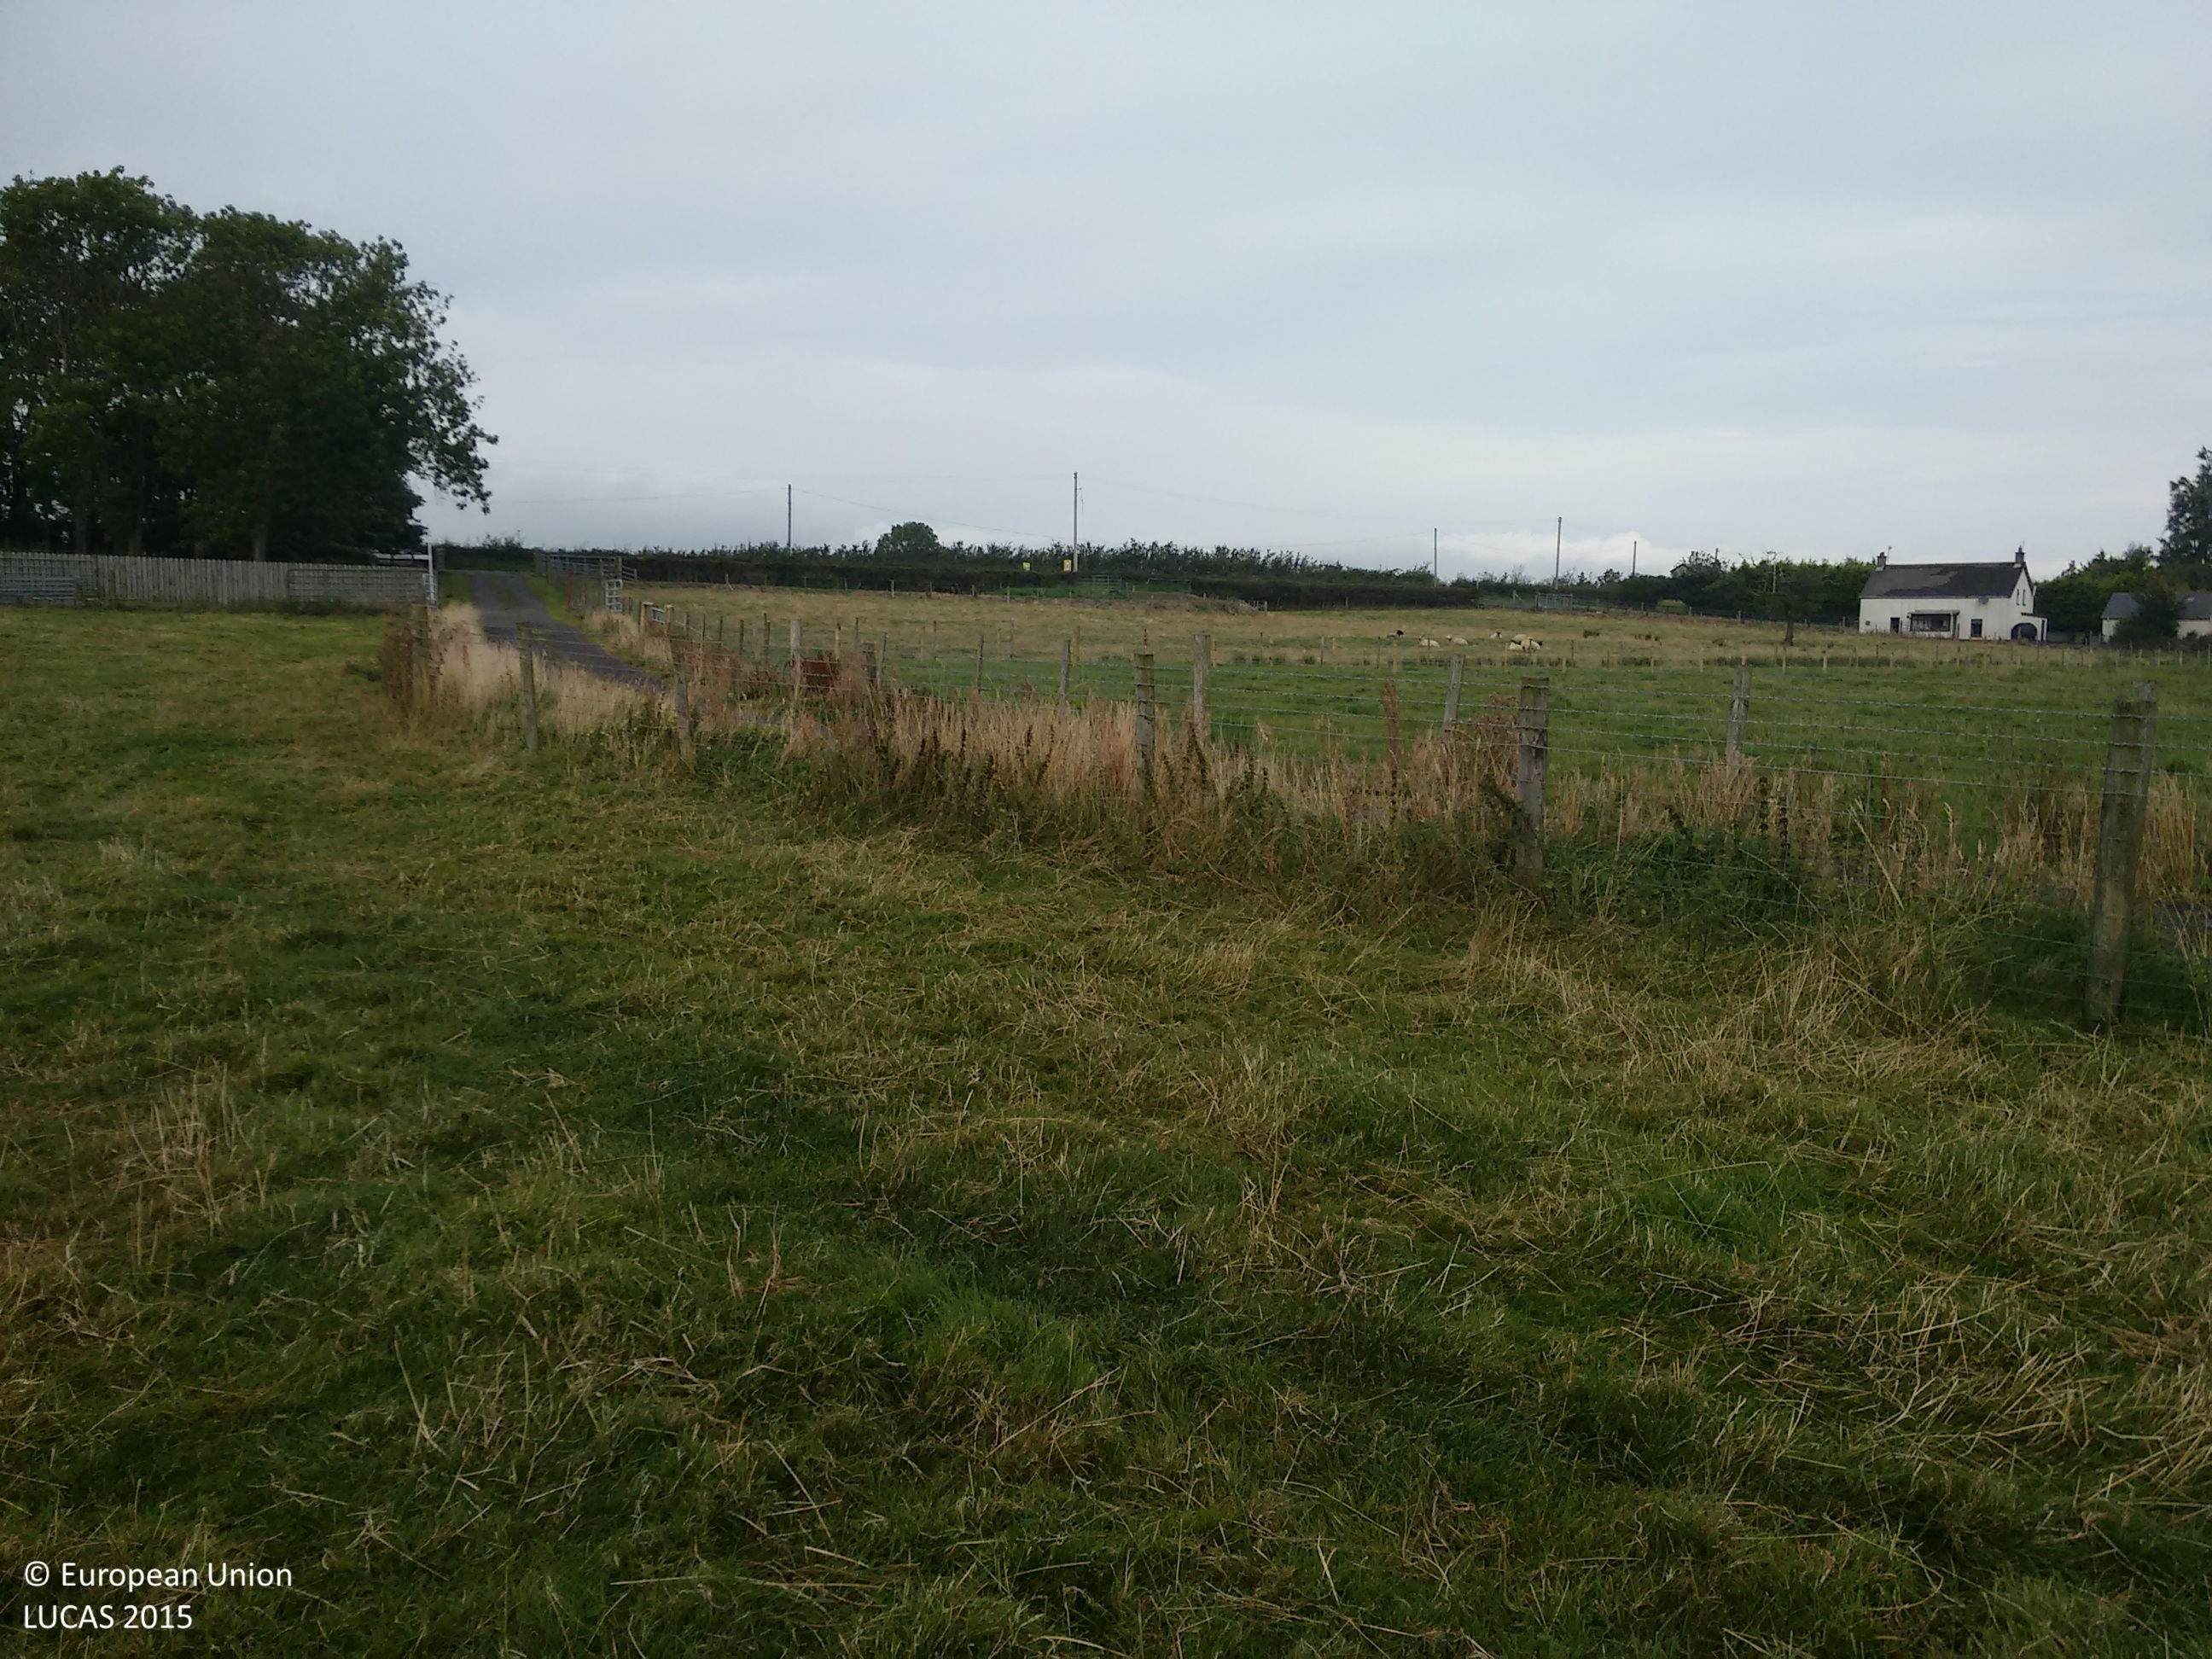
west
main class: Grassland
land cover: Grassland without tree/shrub cover
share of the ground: > 75 %
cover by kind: herbaceous plants 100 %
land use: Agriculture (excluding fallow land and kitchen gardens)
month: September
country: GB
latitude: 54.8212
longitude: -5.7435
